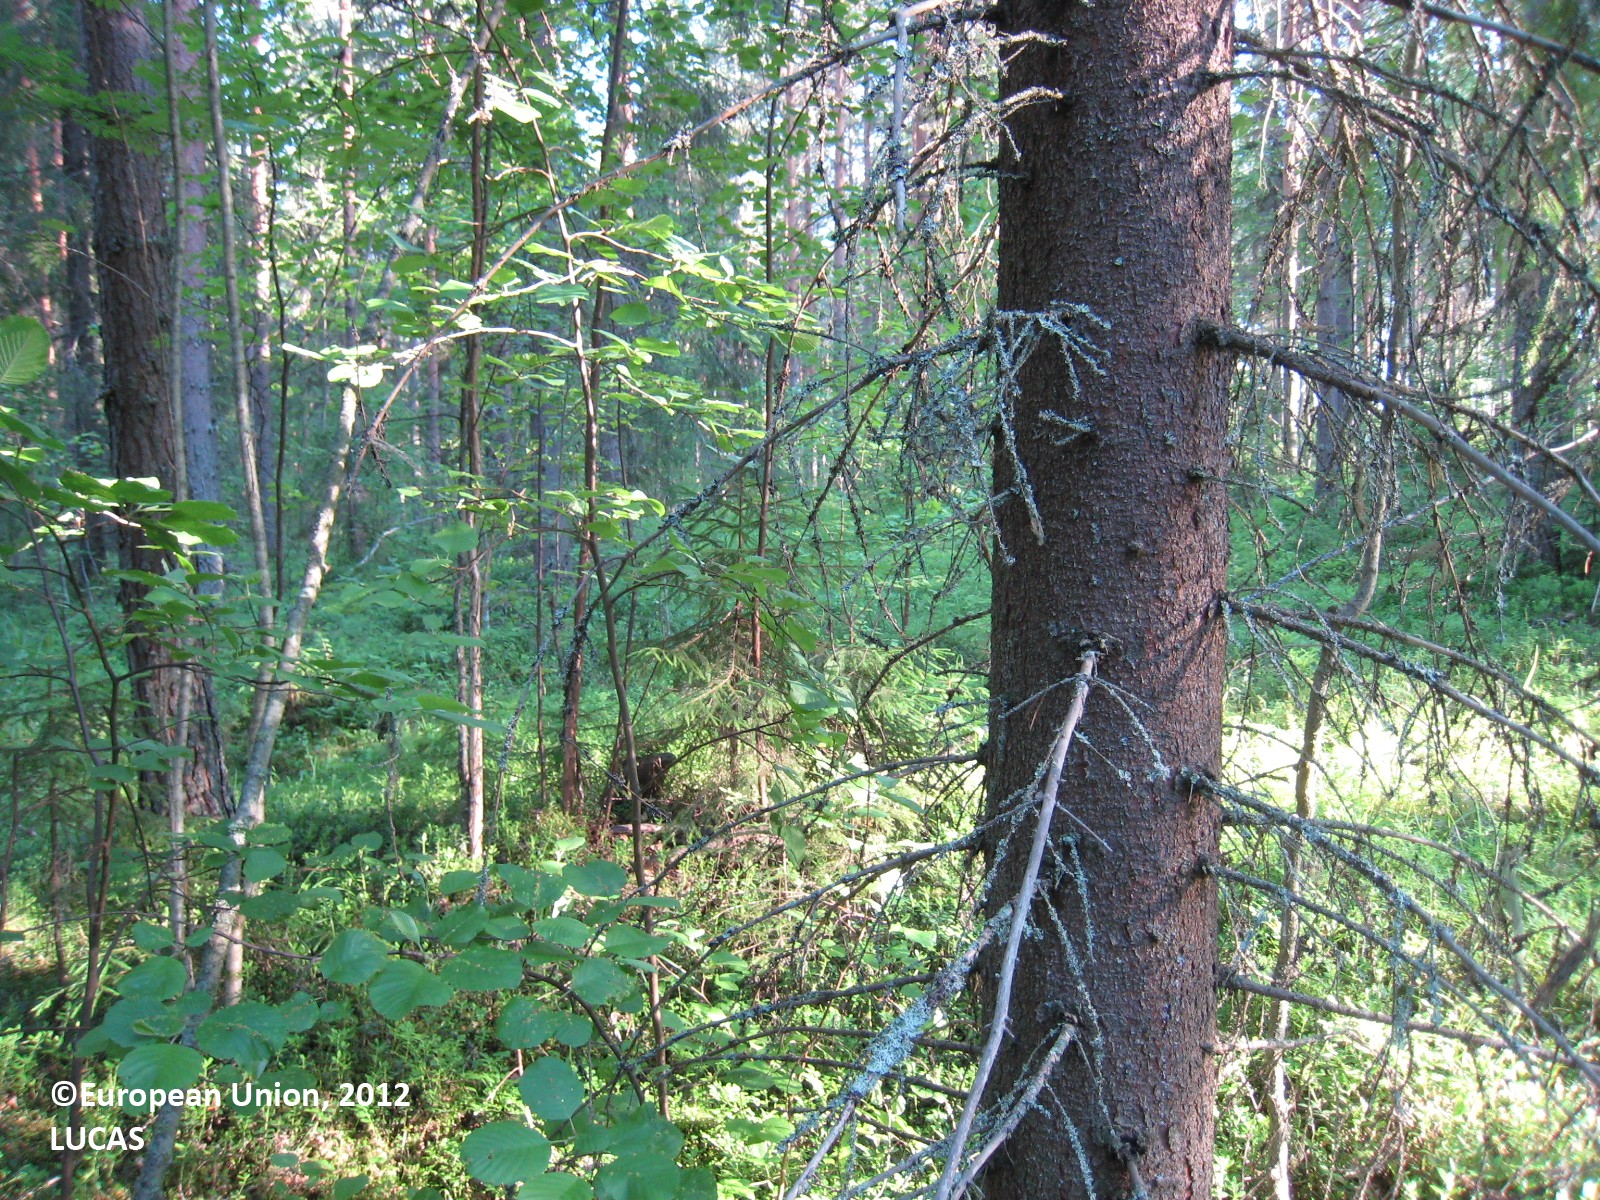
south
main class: Woodland
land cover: Other coniferous woodland
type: boreal forest
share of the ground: 50 - 75 %
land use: Forestry
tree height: > 5 m
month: June
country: FI
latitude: 62.3793
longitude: 26.4758
